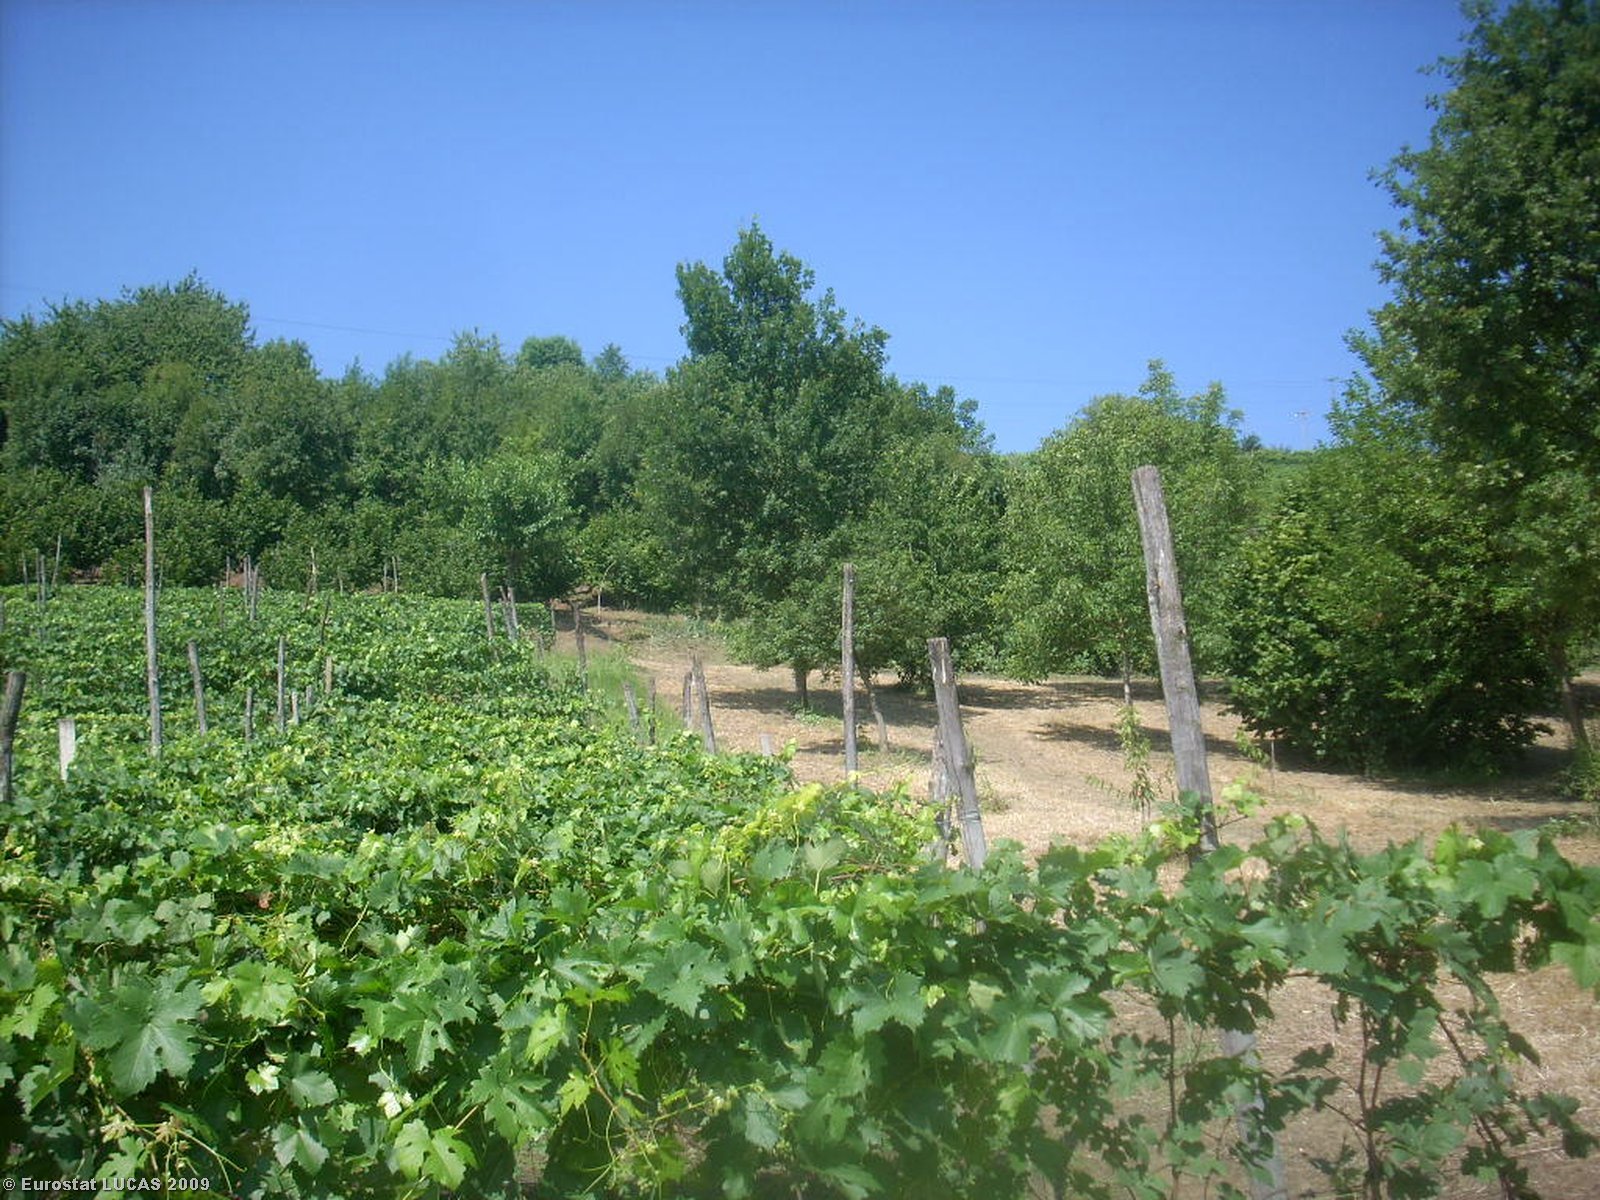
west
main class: Cropland
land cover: Vineyards
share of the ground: < 10 %
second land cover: Grassland with sparse tree/shrub cover
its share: < 10 %
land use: Agriculture (excluding fallow land and kitchen gardens)
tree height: < 5 m
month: July
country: IT
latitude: 44.8021
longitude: 8.0947
